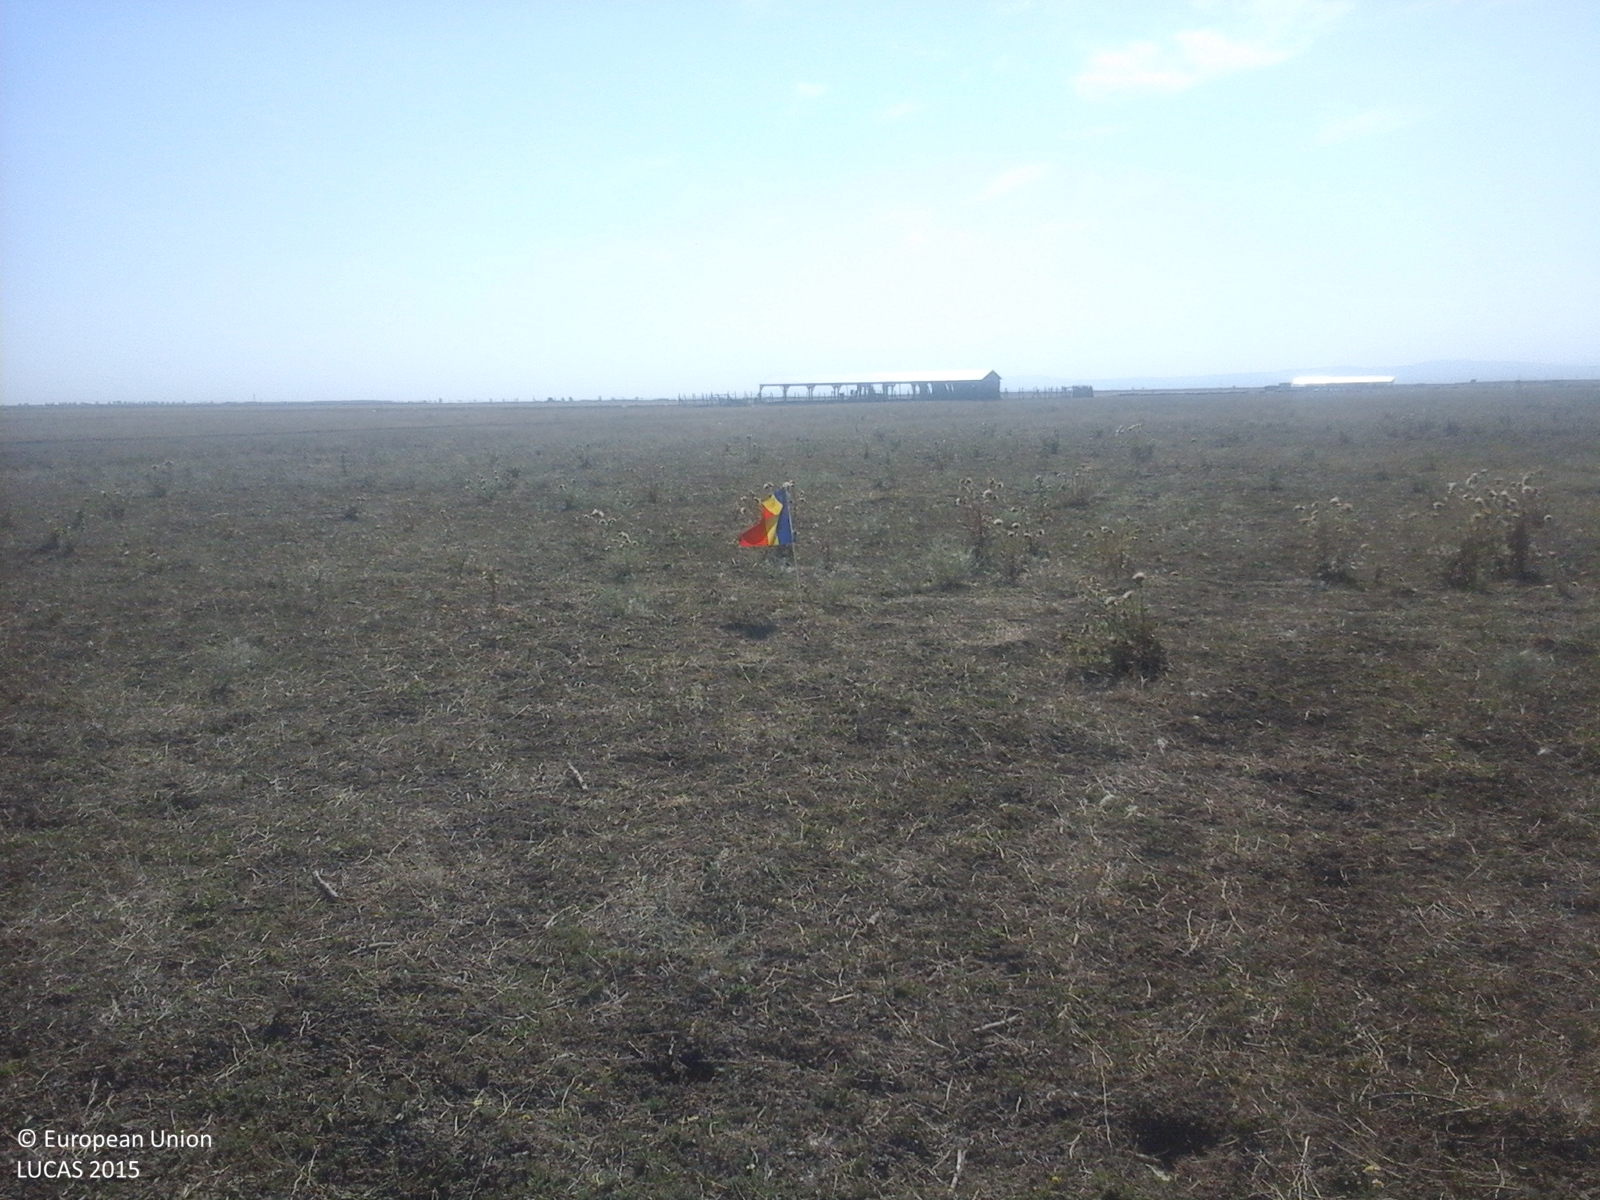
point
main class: Grassland
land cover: Grassland without tree/shrub cover
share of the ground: 50 - 75 %
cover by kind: herbaceous plants 100 %
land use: Agriculture (excluding fallow land and kitchen gardens)
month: August
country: RO
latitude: 45.5716
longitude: 27.4119
